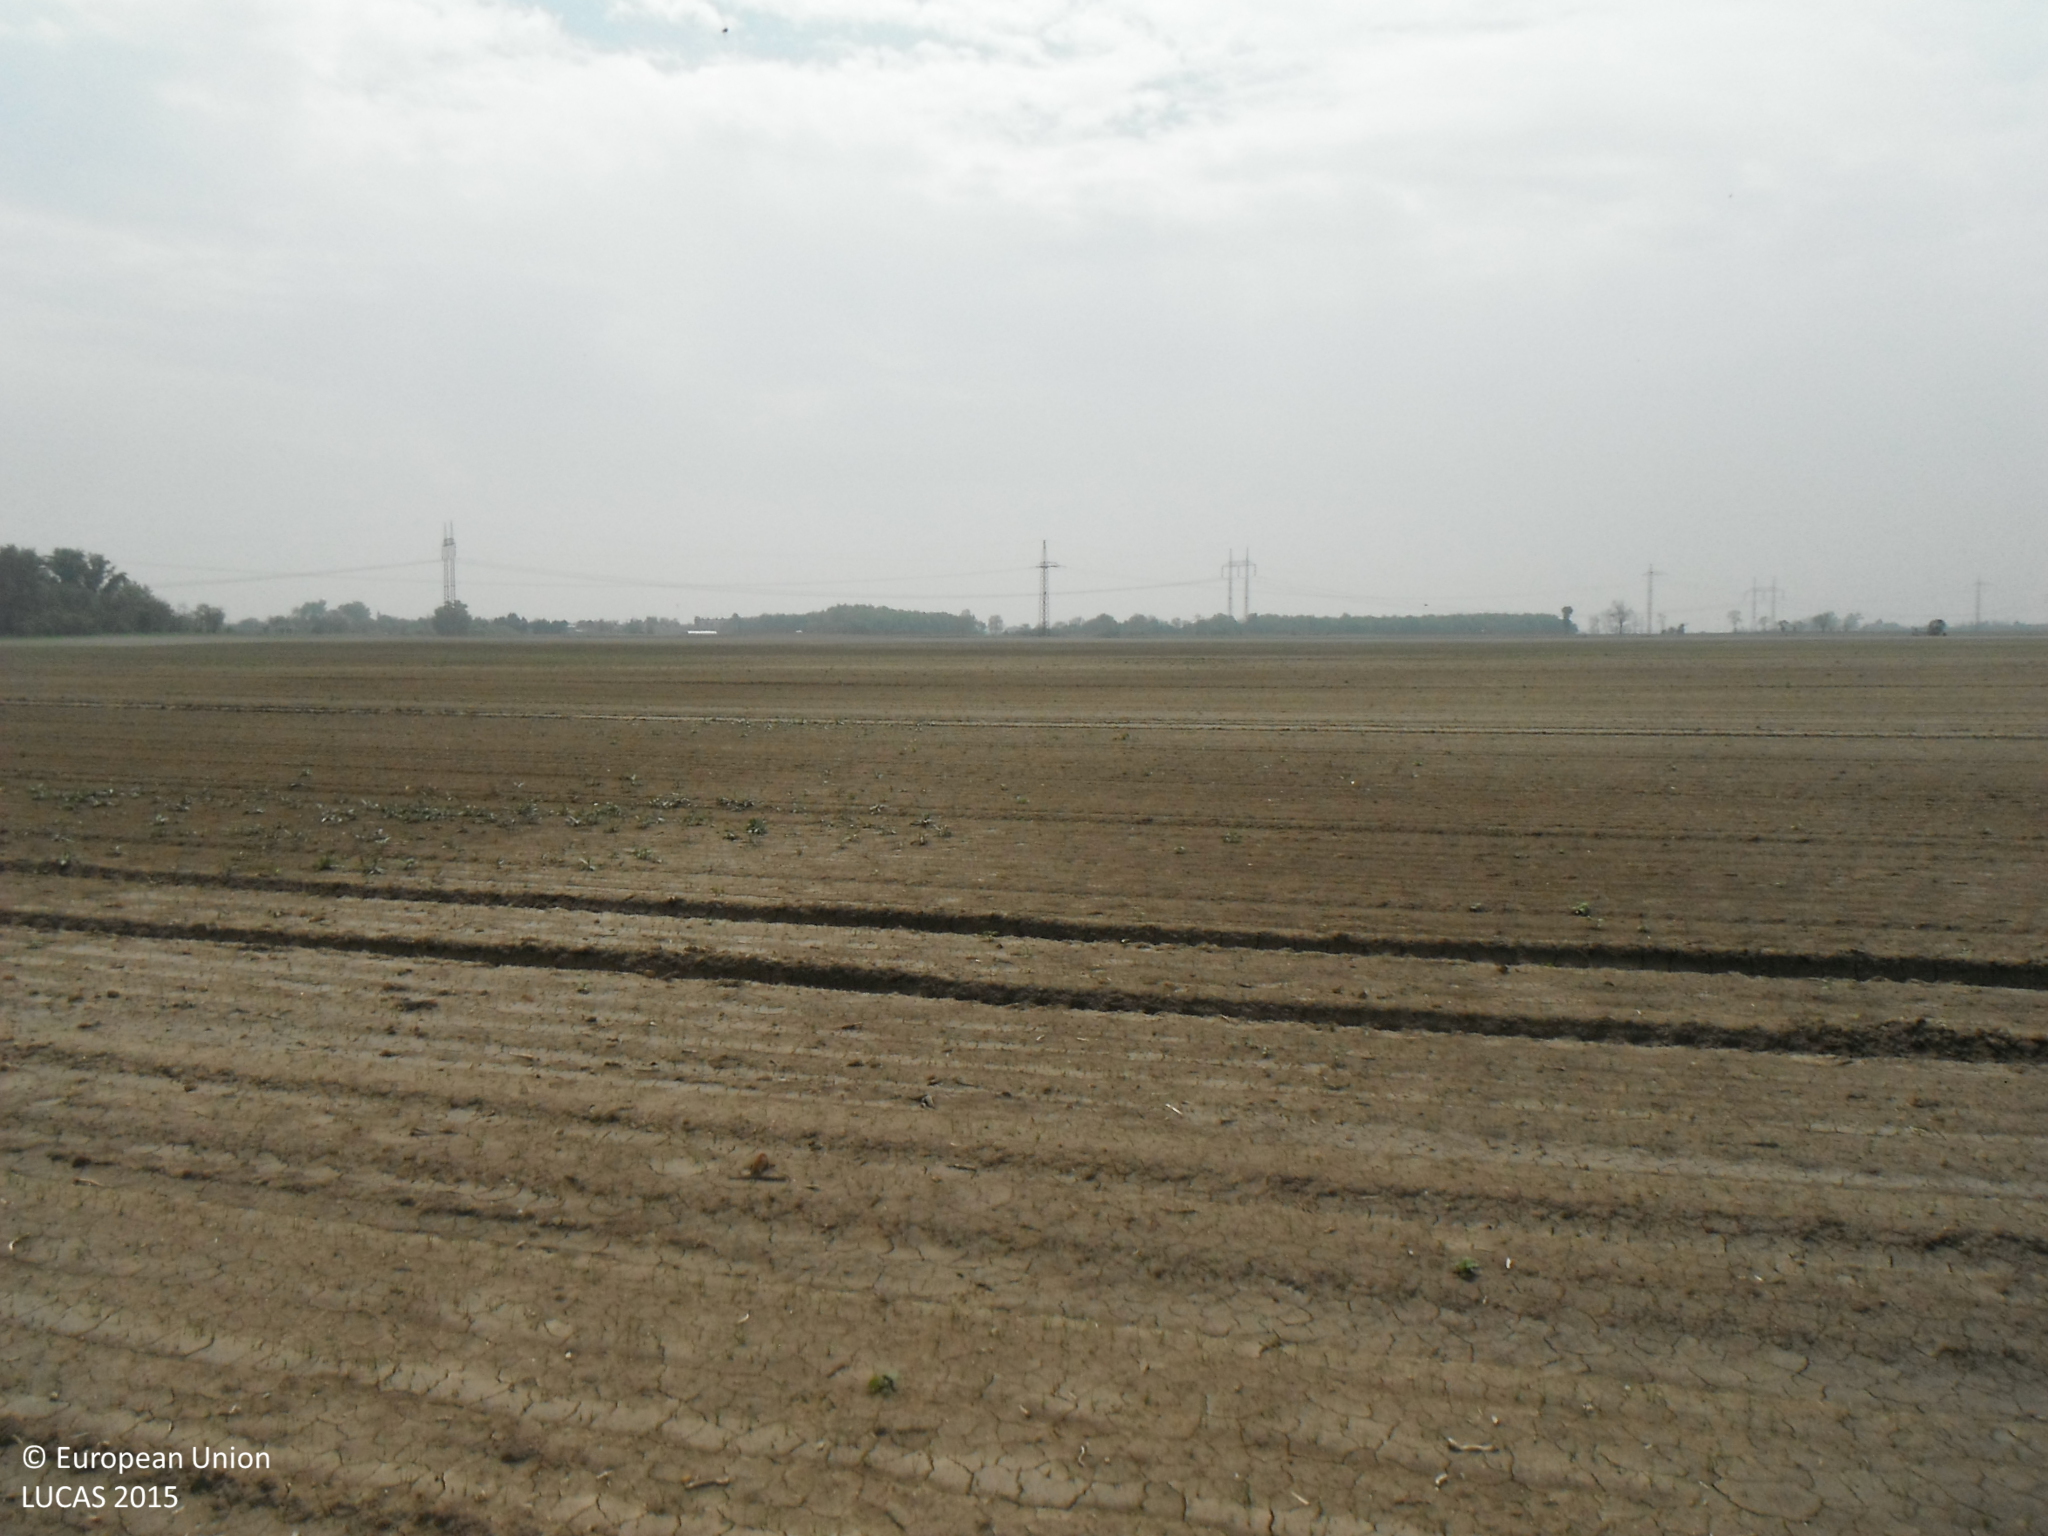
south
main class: Cropland
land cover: Other fresh vegetables
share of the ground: < 10 %
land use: Agriculture (excluding fallow land and kitchen gardens)
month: May
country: SK
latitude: 48.1561
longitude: 17.3896
